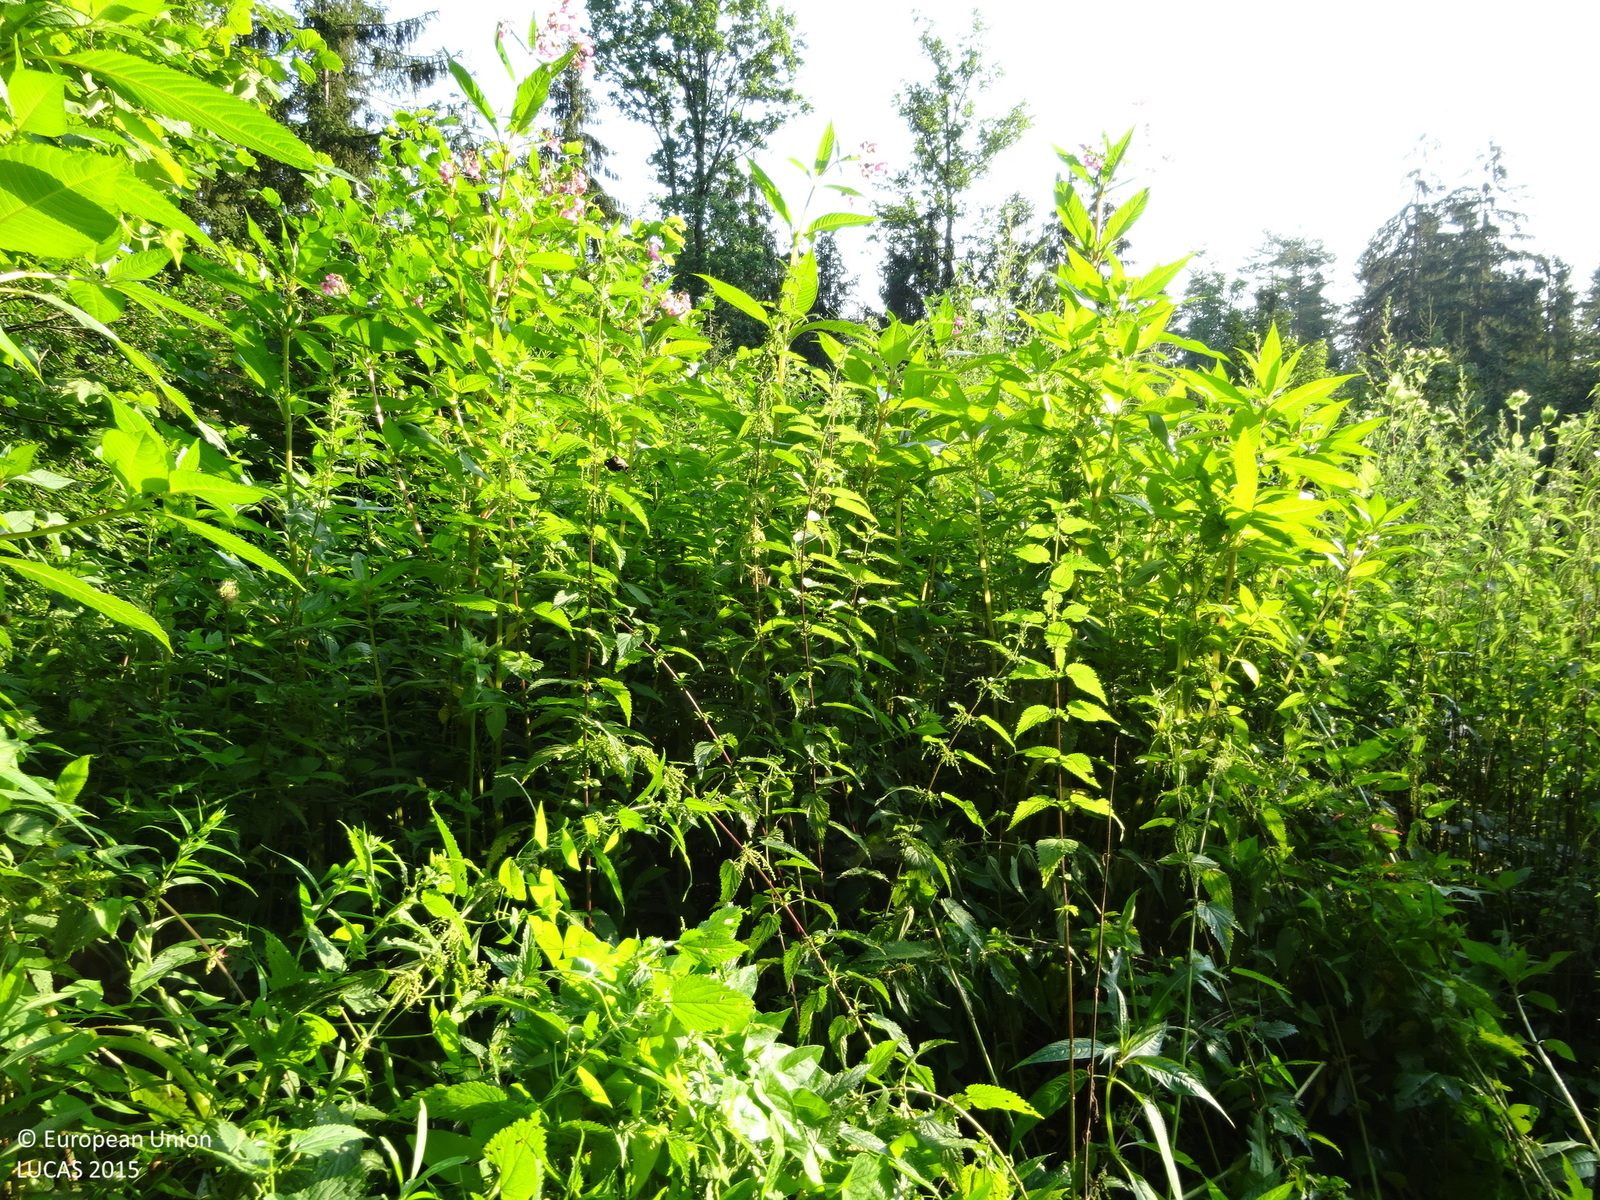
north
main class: Shrubland
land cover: Shrubland with sparse tree cover
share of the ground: 10 - 25 %
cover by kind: shrubs 65 %, herbaceous plants 30 %, broadleaved forest trees 5 %
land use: Abandoned areas
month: July
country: AT
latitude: 46.9175
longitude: 15.4226
